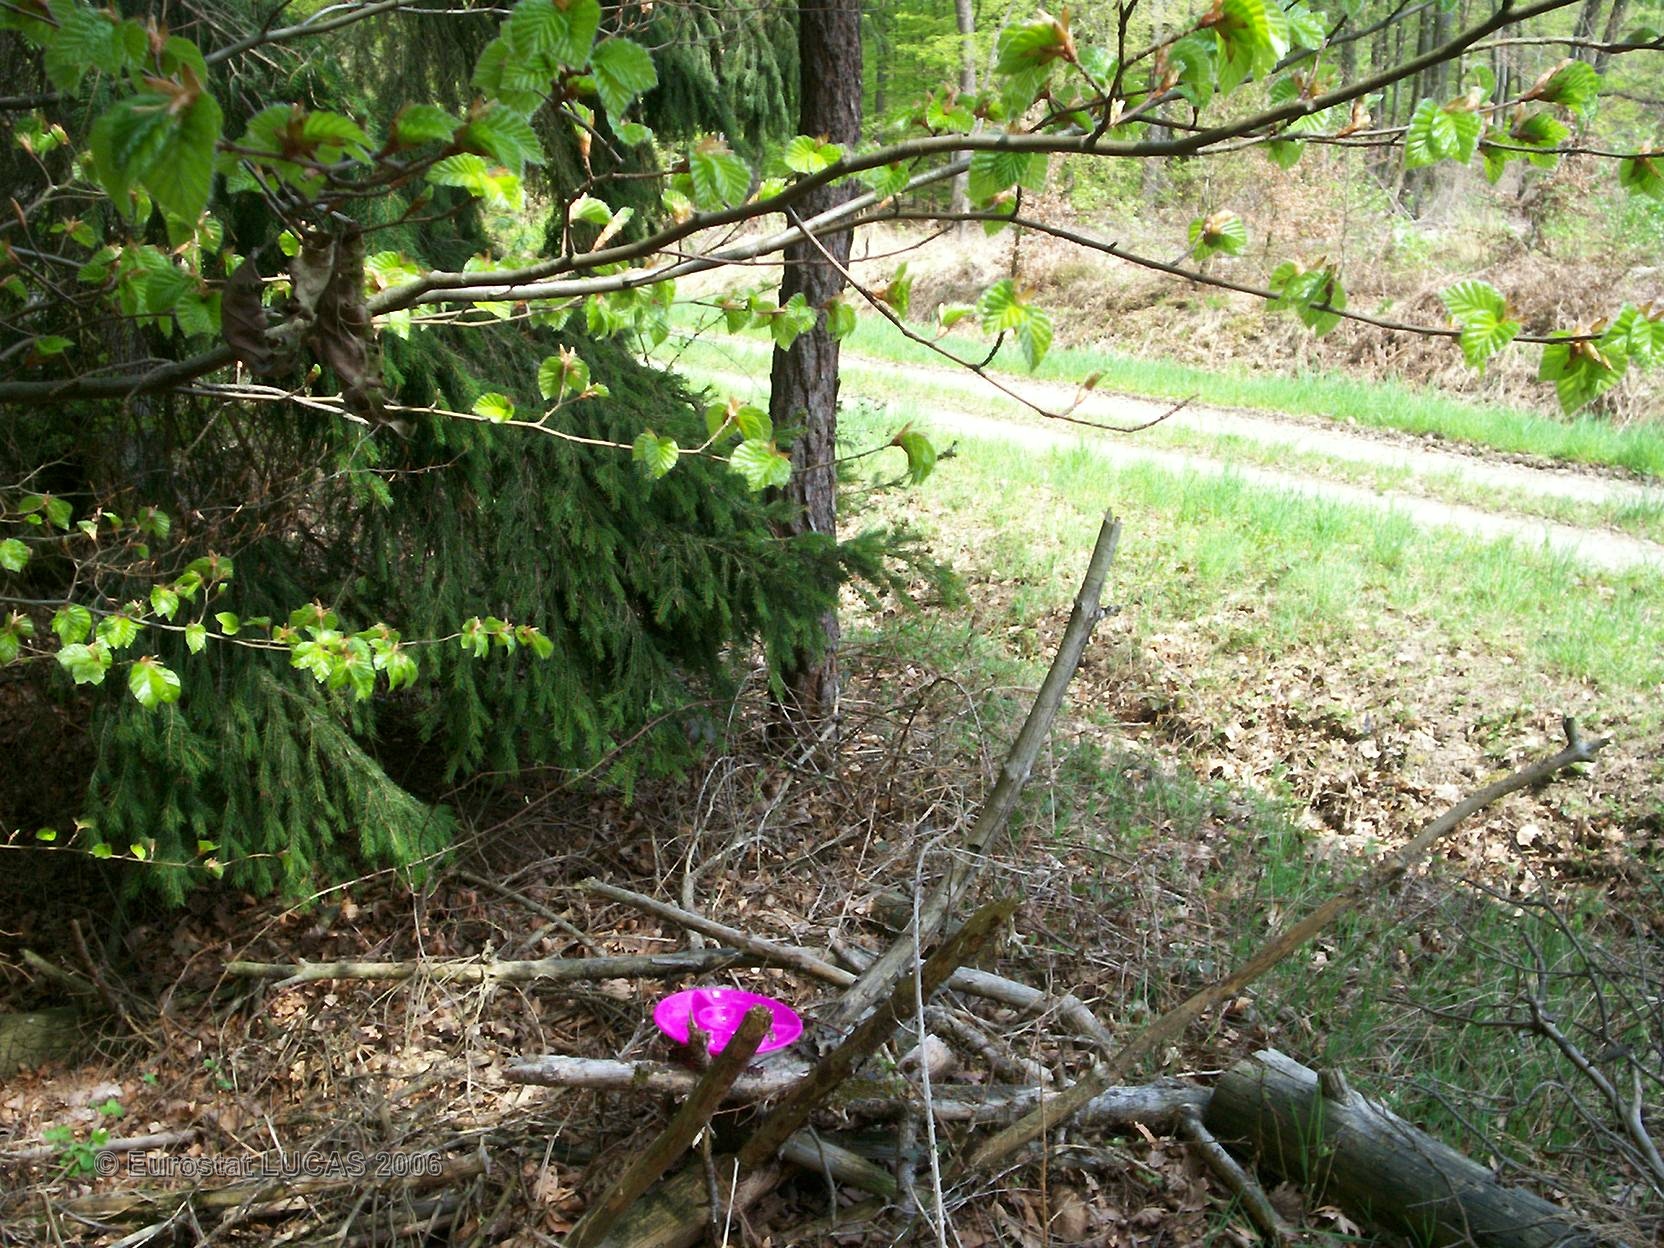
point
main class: Woodland
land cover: Mixed forest
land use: Forestry
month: May
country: FR
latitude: 48.9946
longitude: 7.0620
